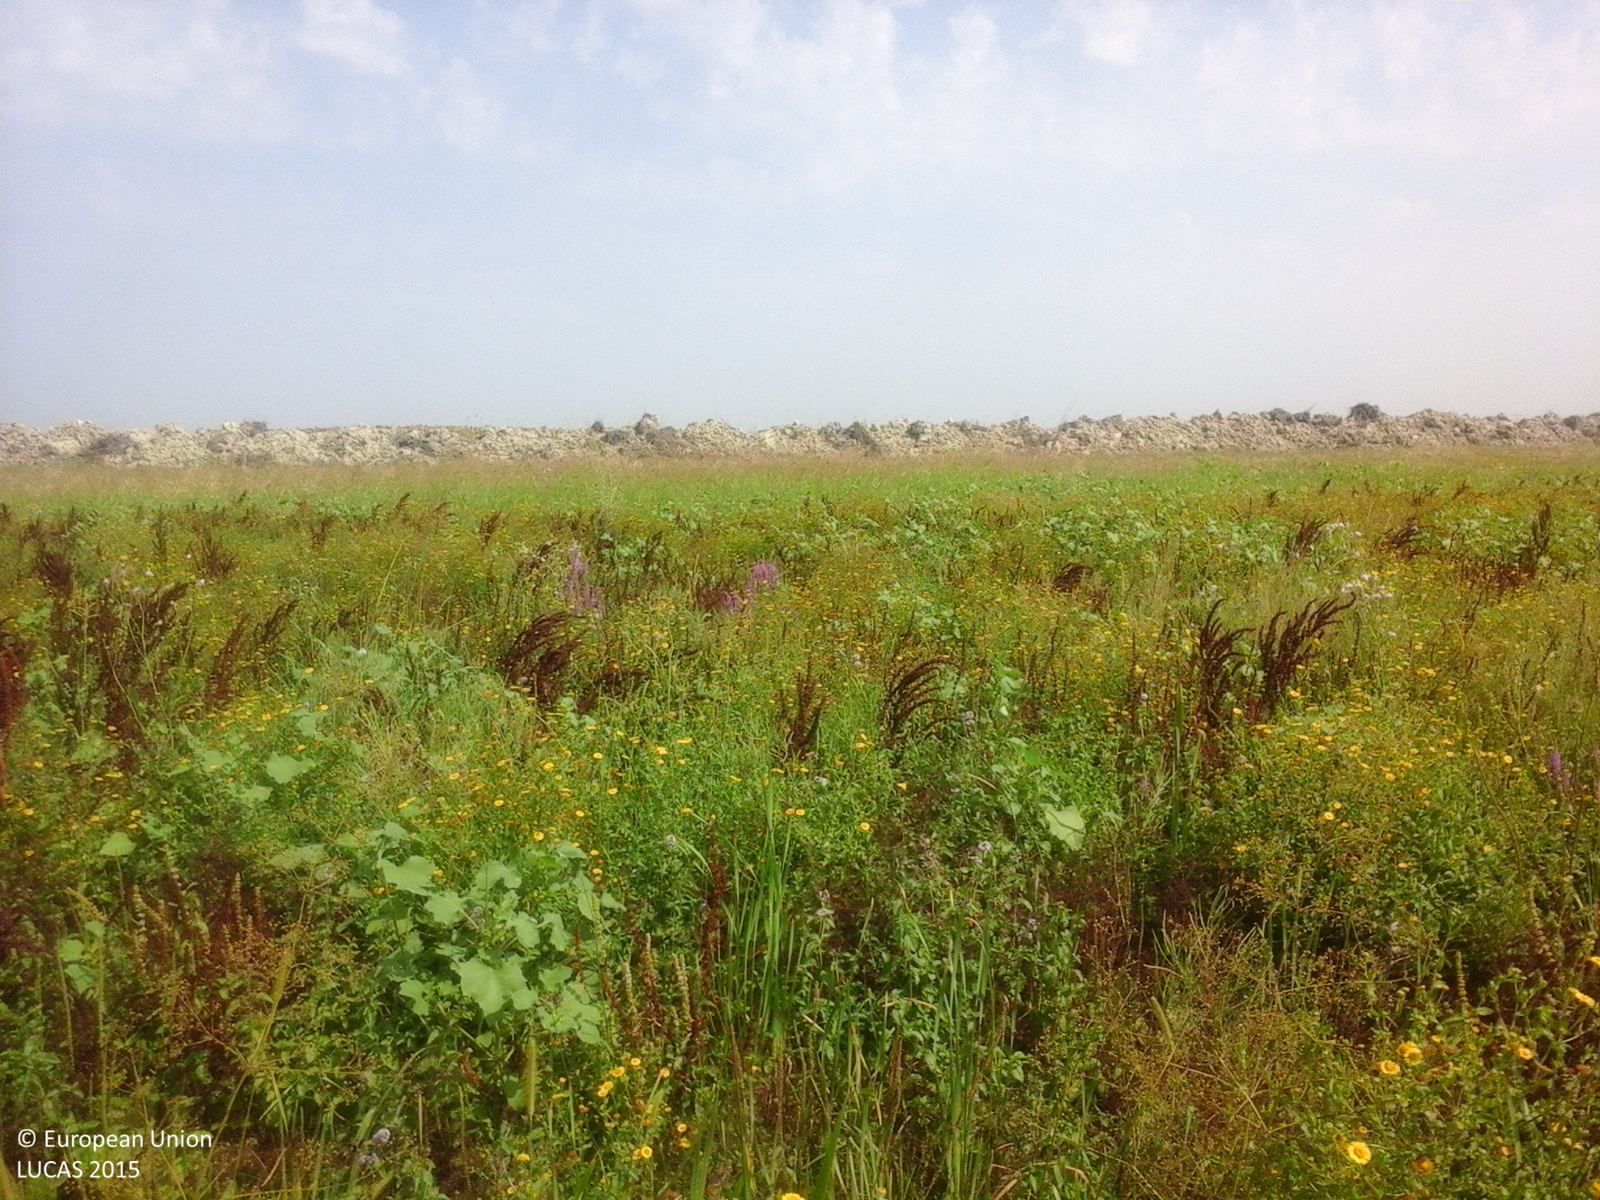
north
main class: Grassland
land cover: Spontaneously vegetated surfaces
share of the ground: > 75 %
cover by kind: herbaceous plants 100 %
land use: Agriculture (excluding fallow land and kitchen gardens)
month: August
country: RO
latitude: 43.8495
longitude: 23.6212
